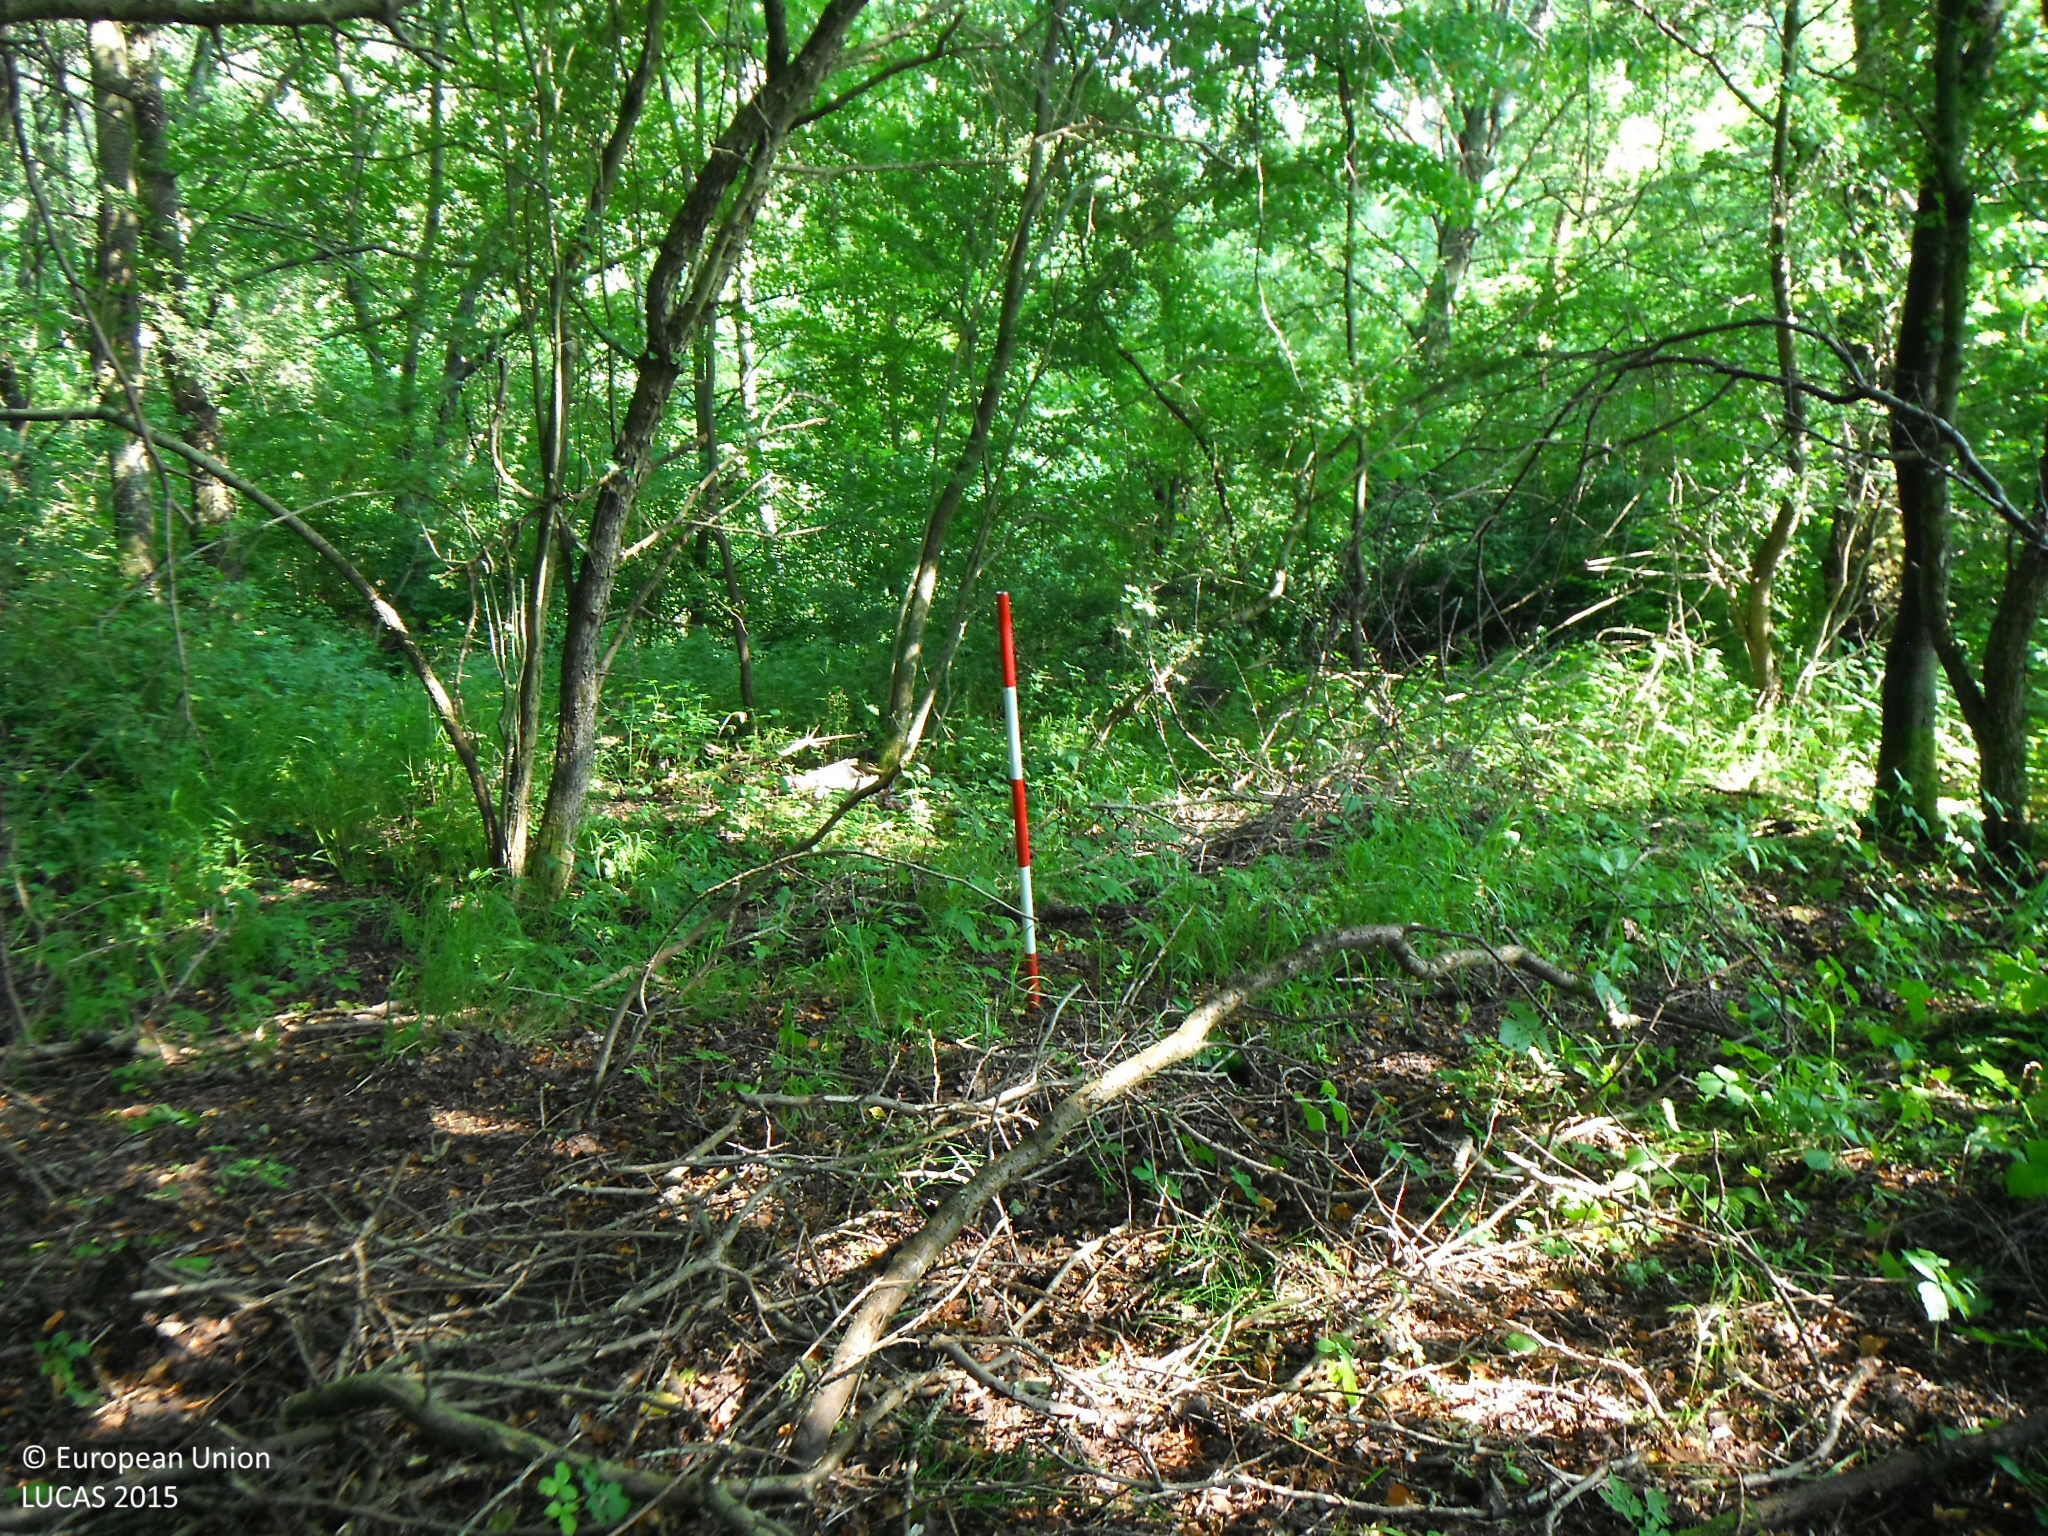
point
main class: Woodland
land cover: Broadleaved woodland
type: mesophytic deciduous forest
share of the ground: > 75 %
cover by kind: broadleaved forest trees 90 %, shrubs 10 %
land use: Semi-natural and natural areas not in use
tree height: > 5 m
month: July
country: SK
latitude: 49.3242
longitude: 21.1755
